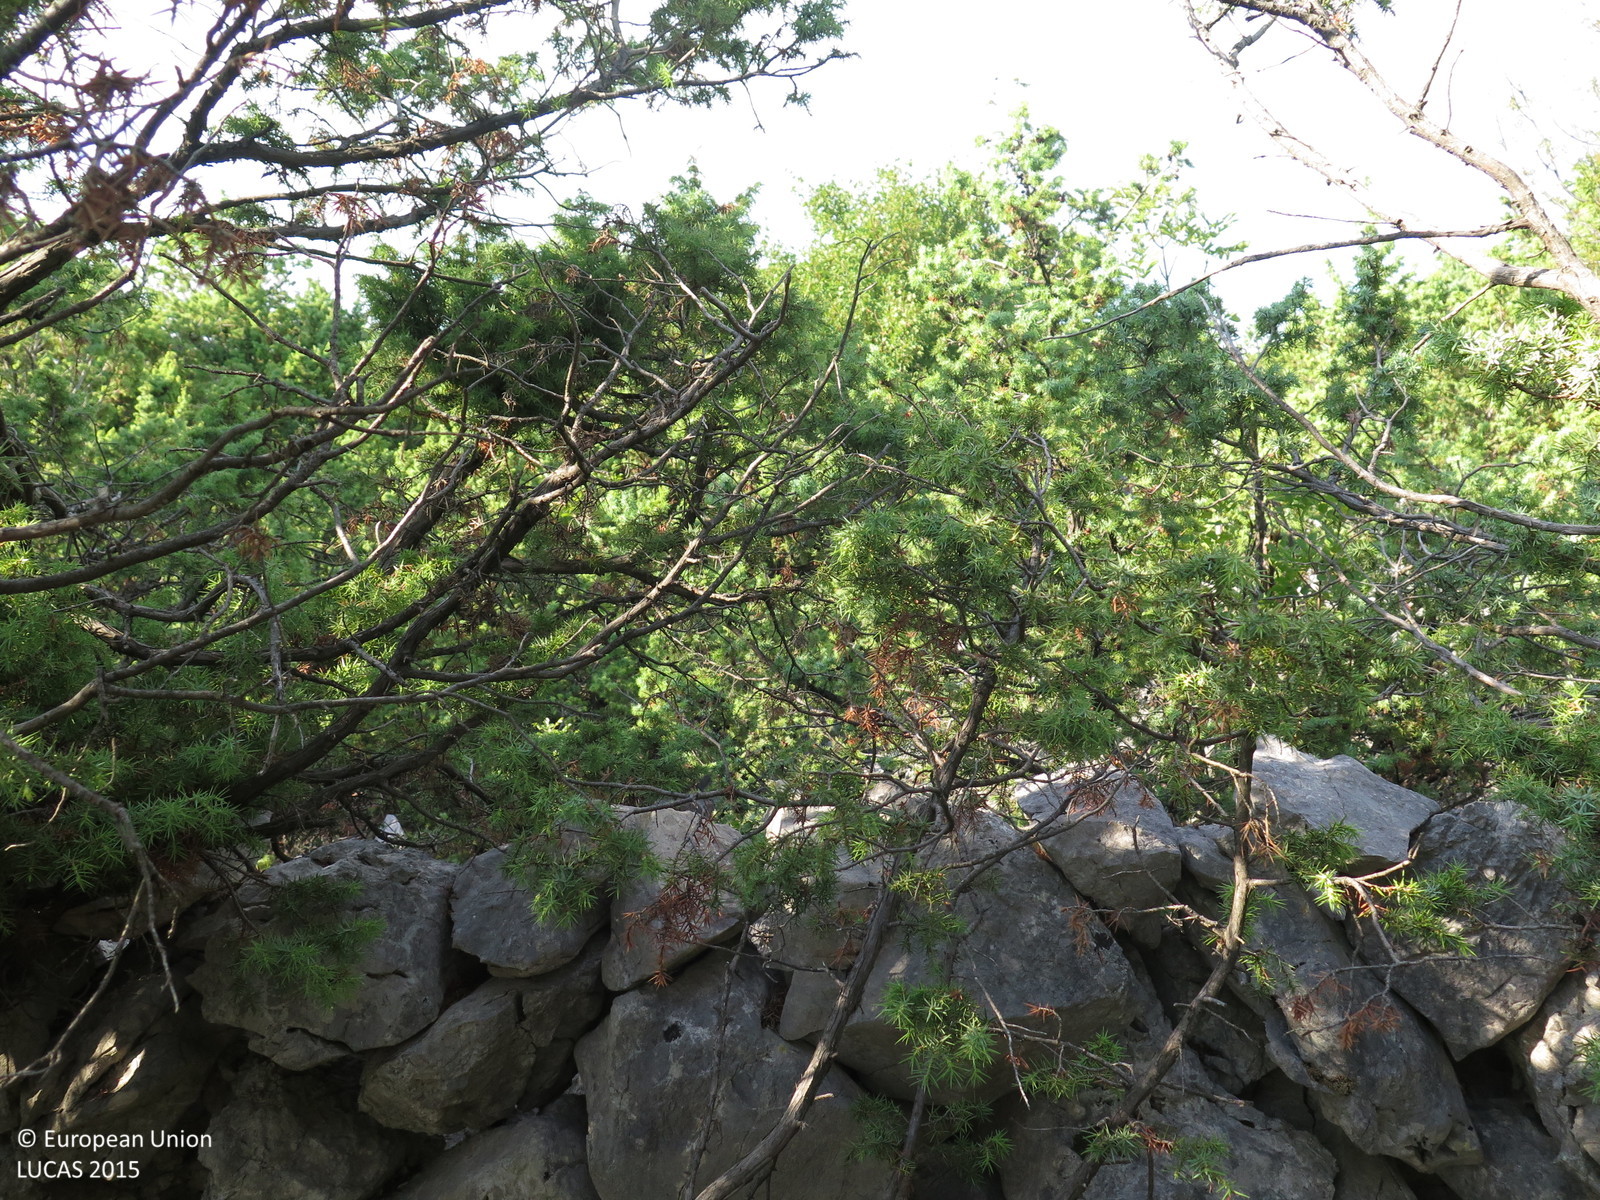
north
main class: Woodland
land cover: Broadleaved woodland
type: thermophilous deciduous forest
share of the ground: > 75 %
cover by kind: broadleaved forest trees 90 %, shrubs 5 %, unconsolidated bare surface 5 %
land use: Semi-natural and natural areas not in use
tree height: < 5 m
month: August
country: HR
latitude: 45.0408
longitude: 14.6534
